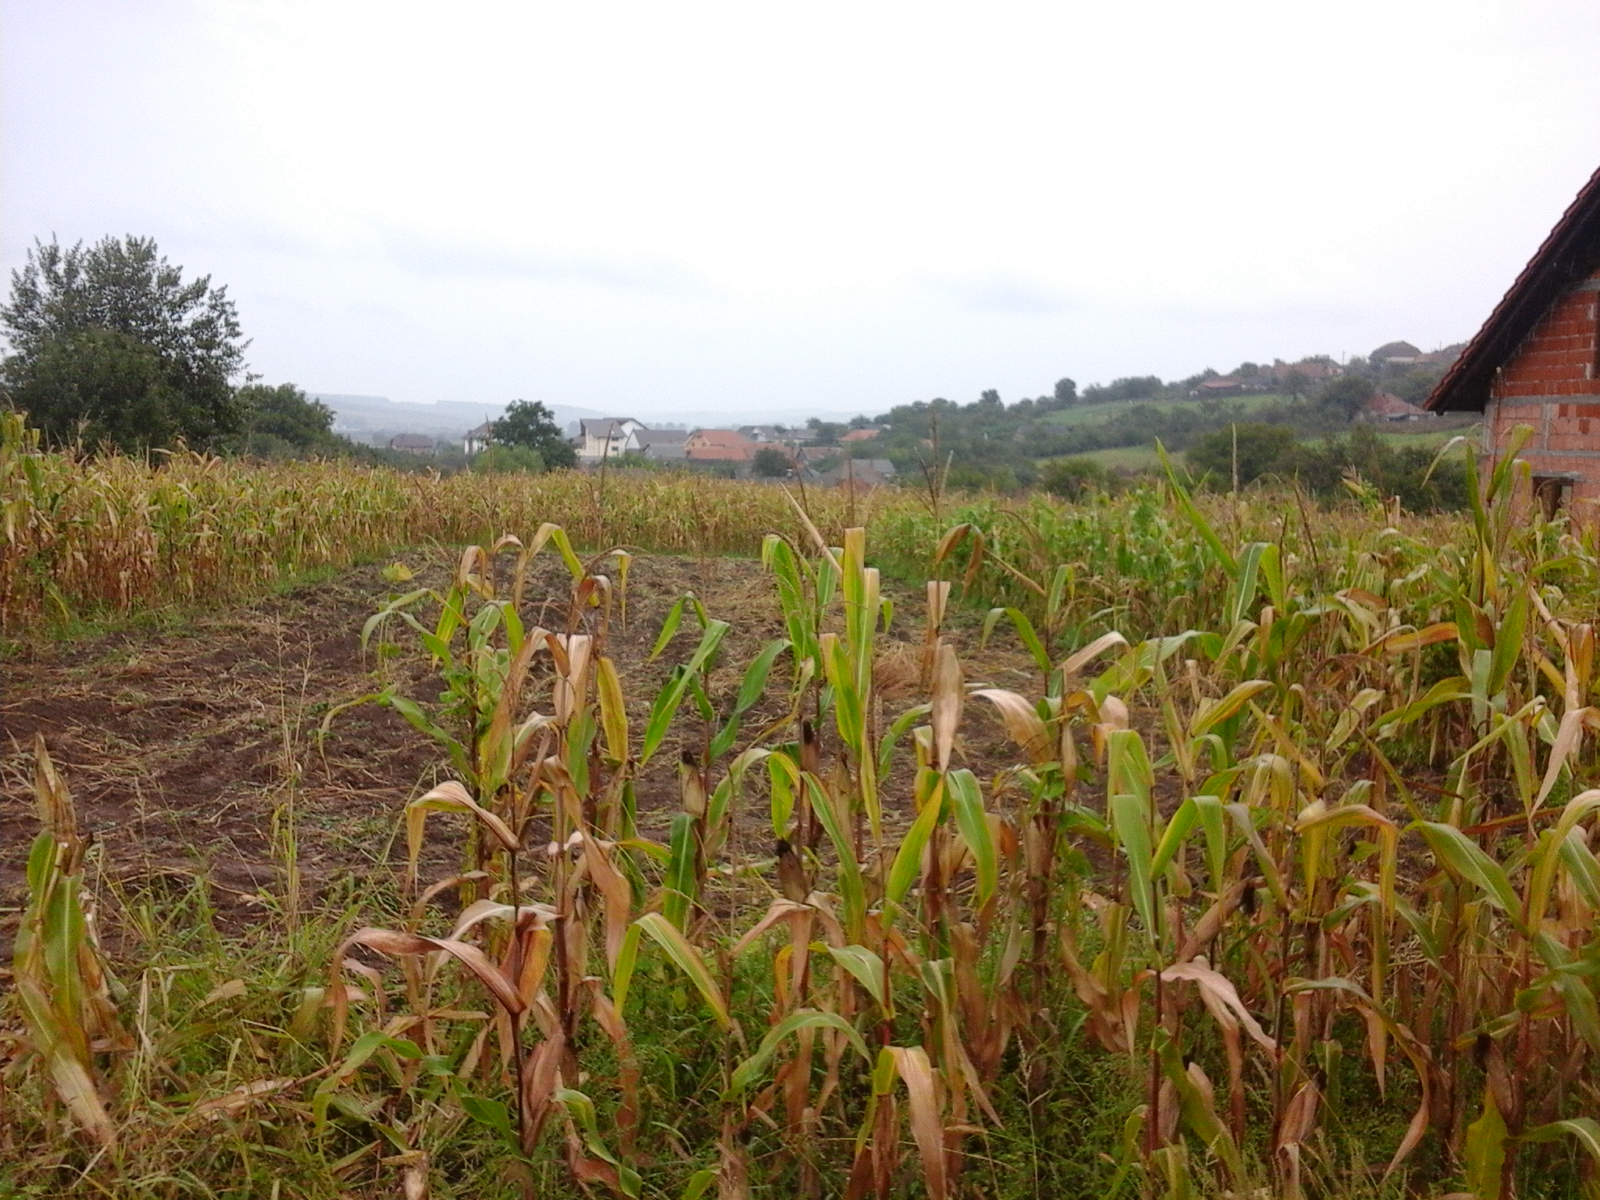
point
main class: Cropland
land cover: Maize
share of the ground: > 75 %
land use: Agriculture (excluding fallow land and kitchen gardens)
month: September
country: RO
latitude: 47.2105
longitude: 22.5596
